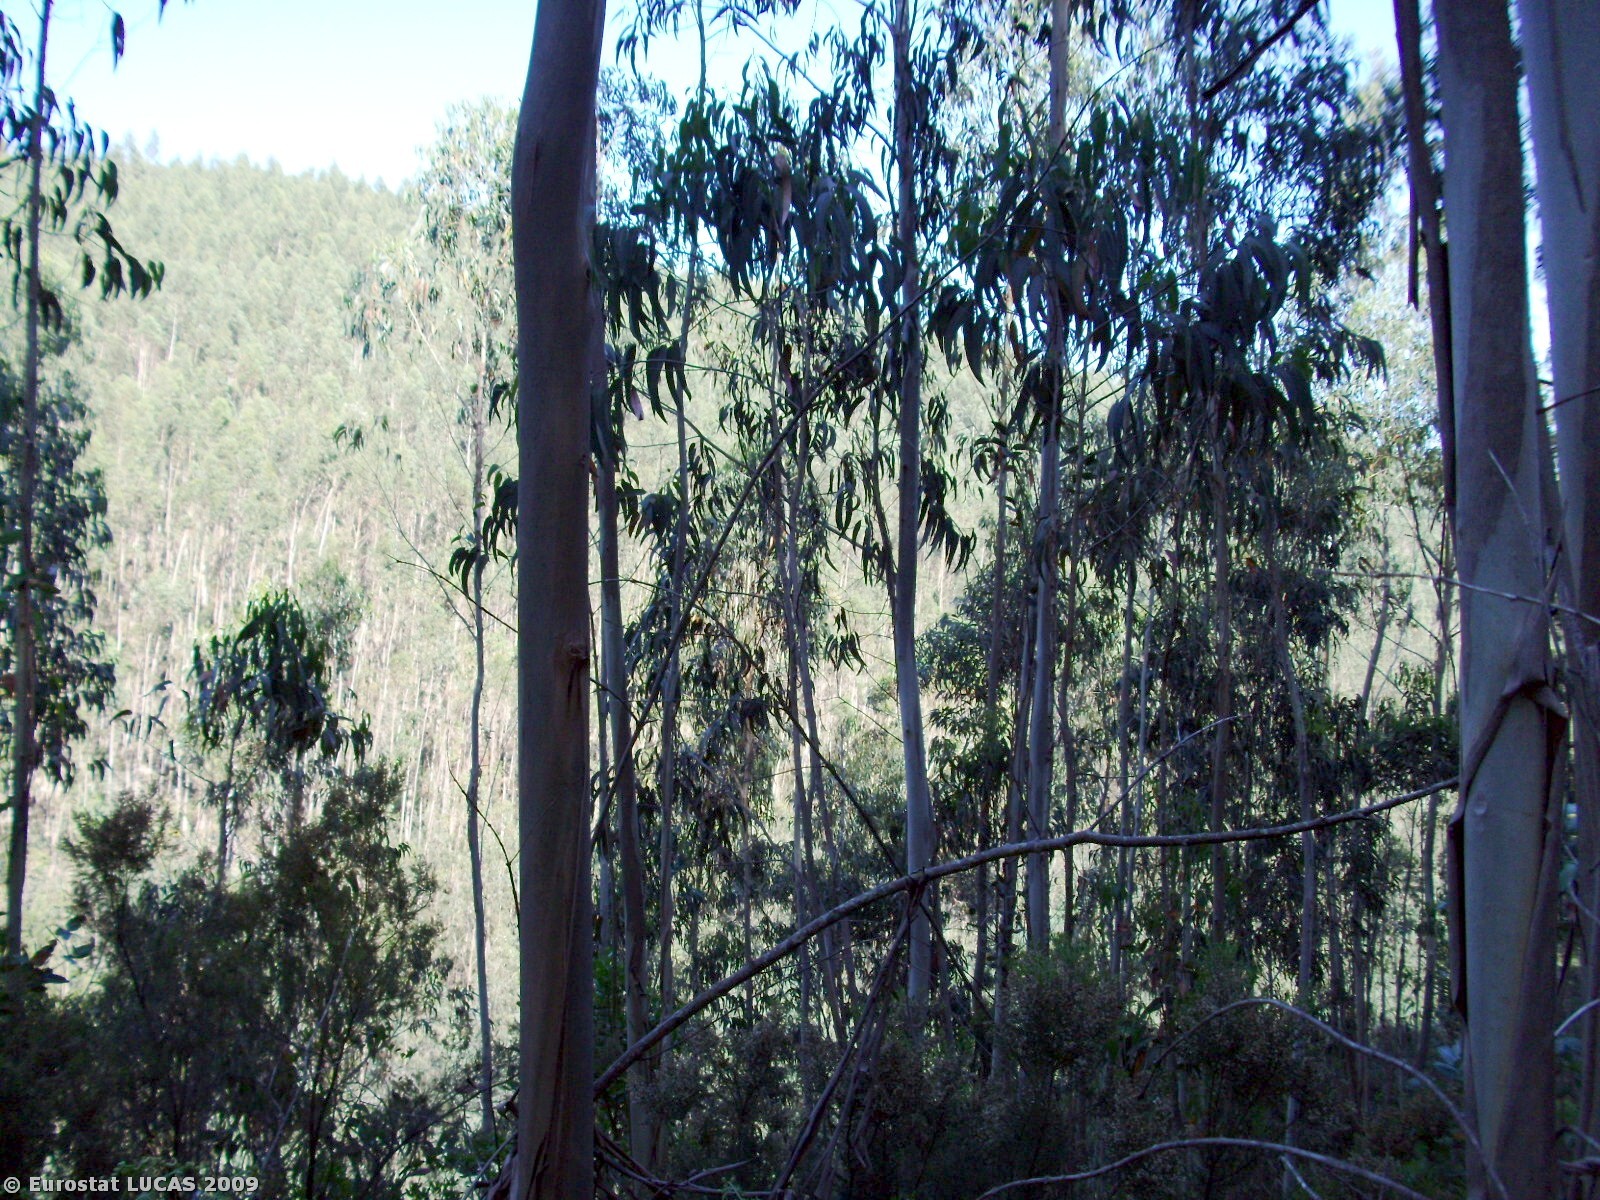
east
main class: Woodland
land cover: Broadleaved woodland
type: plantations and self-sown exotic forest
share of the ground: > 75 %
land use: Forestry
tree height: > 5 m
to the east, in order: Broadleaved woodland; Tracks; Broadleaved woodland; Inland running water; Broadleaved woodland; Tracks; Broadleaved woodland; Tracks; Broadleaved woodland
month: May
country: PT
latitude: 40.5834
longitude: -8.3895
